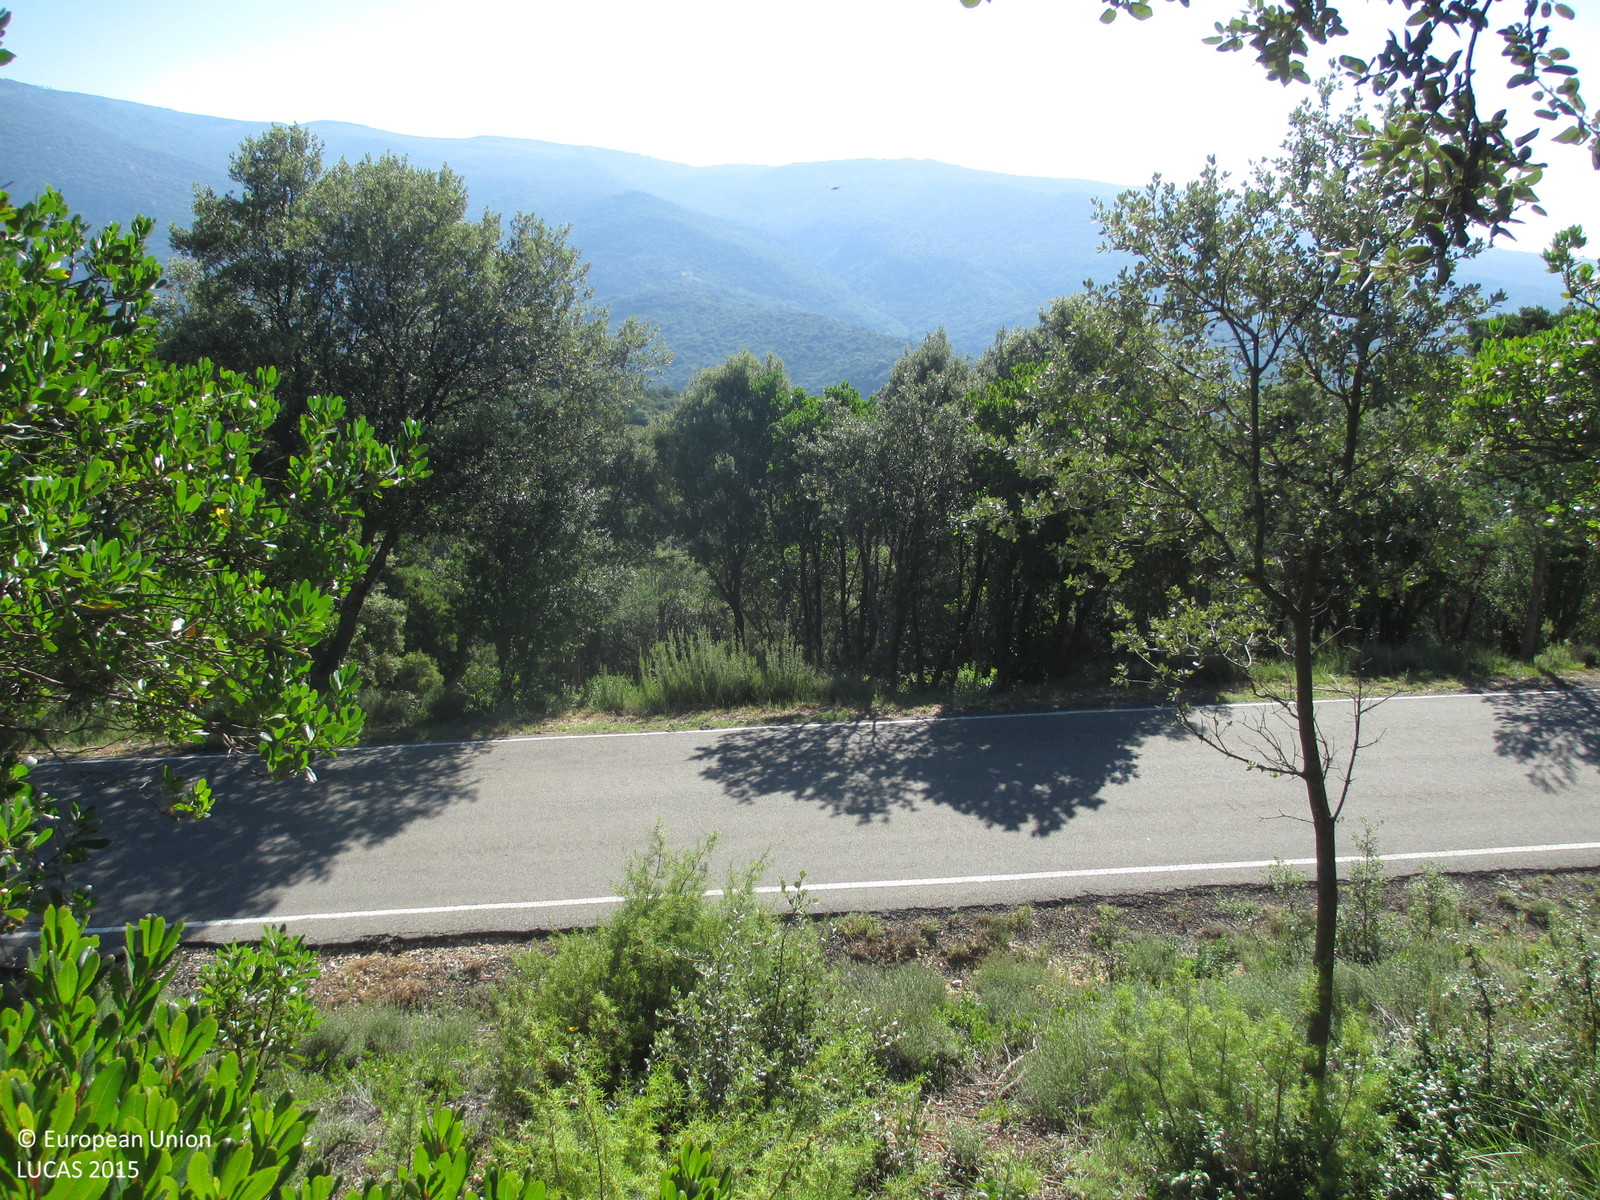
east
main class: Woodland
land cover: Broadleaved woodland
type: broadleaved evergreen forest
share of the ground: > 75 %
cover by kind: broadleaved forest trees 90 %, shrubs 5 %, herbaceous plants 5 %
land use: Semi-natural and natural areas not in use
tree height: < 5 m
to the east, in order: Broadleaved woodland; Fences; Broadleaved woodland; Paved roads, cycling and walking lanes; Broadleaved woodland; Fences; Tracks; Broadleaved woodland; Tracks; Broadleaved woodland
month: June
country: ES
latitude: 42.2064
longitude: -0.0616
